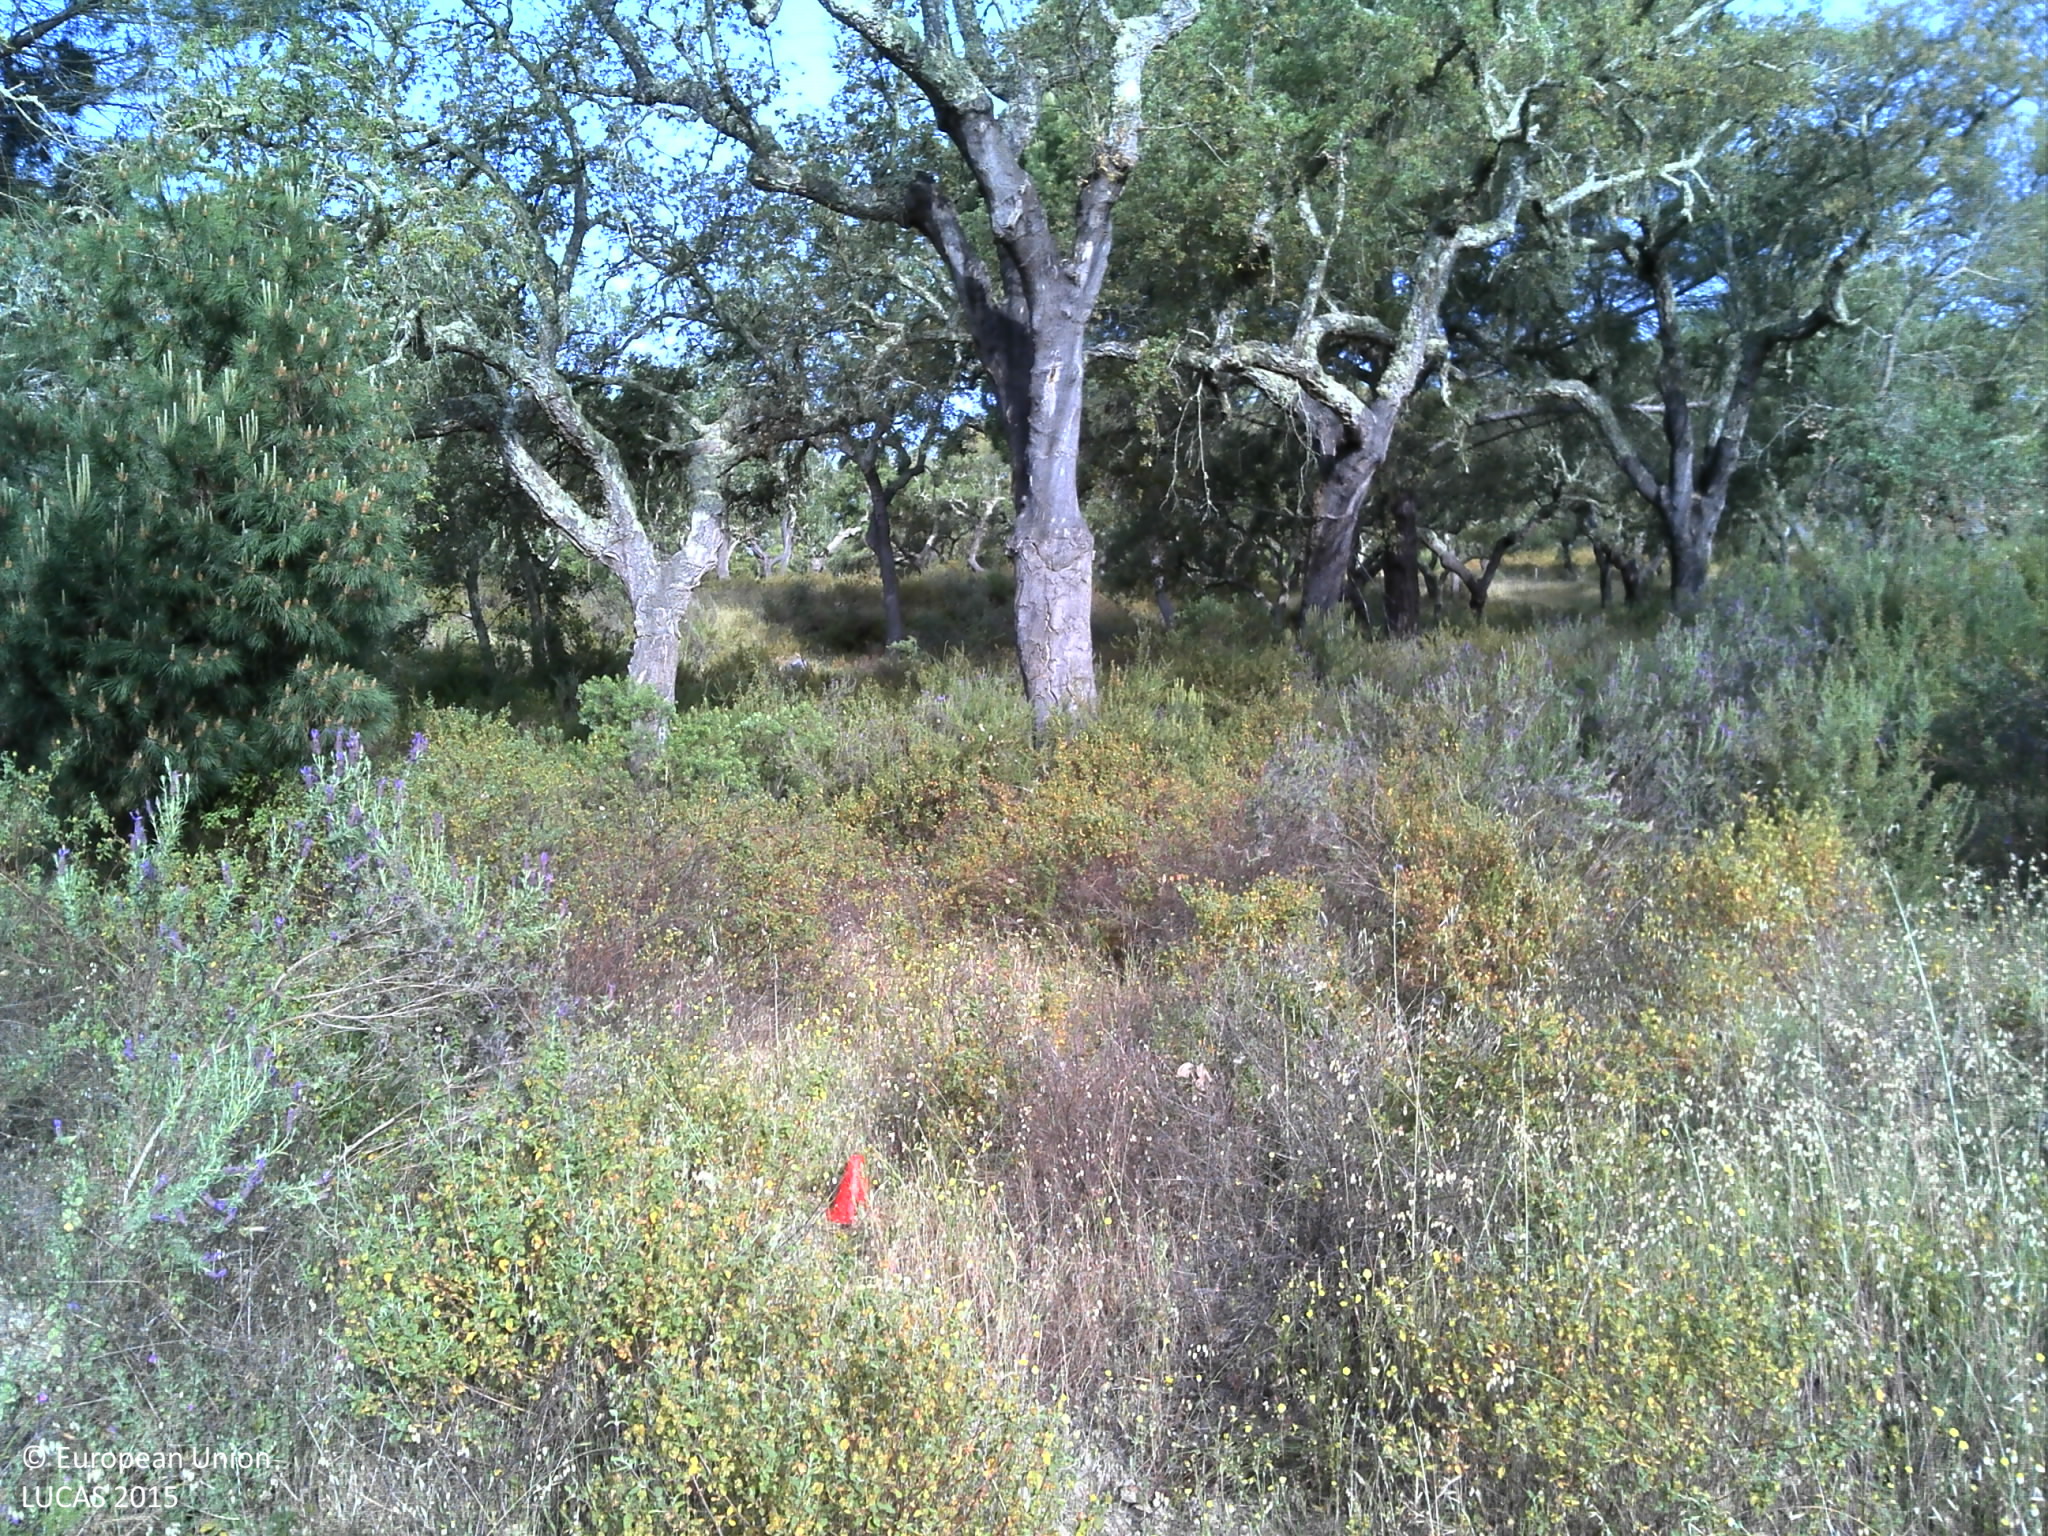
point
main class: Woodland
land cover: Broadleaved woodland
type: broadleaved evergreen forest
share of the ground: 10 - 25 %
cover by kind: shrubs 30 %, herbaceous plants 30 %, broadleaved forest trees 25 %, unconsolidated bare surface 10 %, coniferous forest trees 5 %
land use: Forestry
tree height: > 5 m
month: May
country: PT
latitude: 38.3151
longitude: -8.4505
